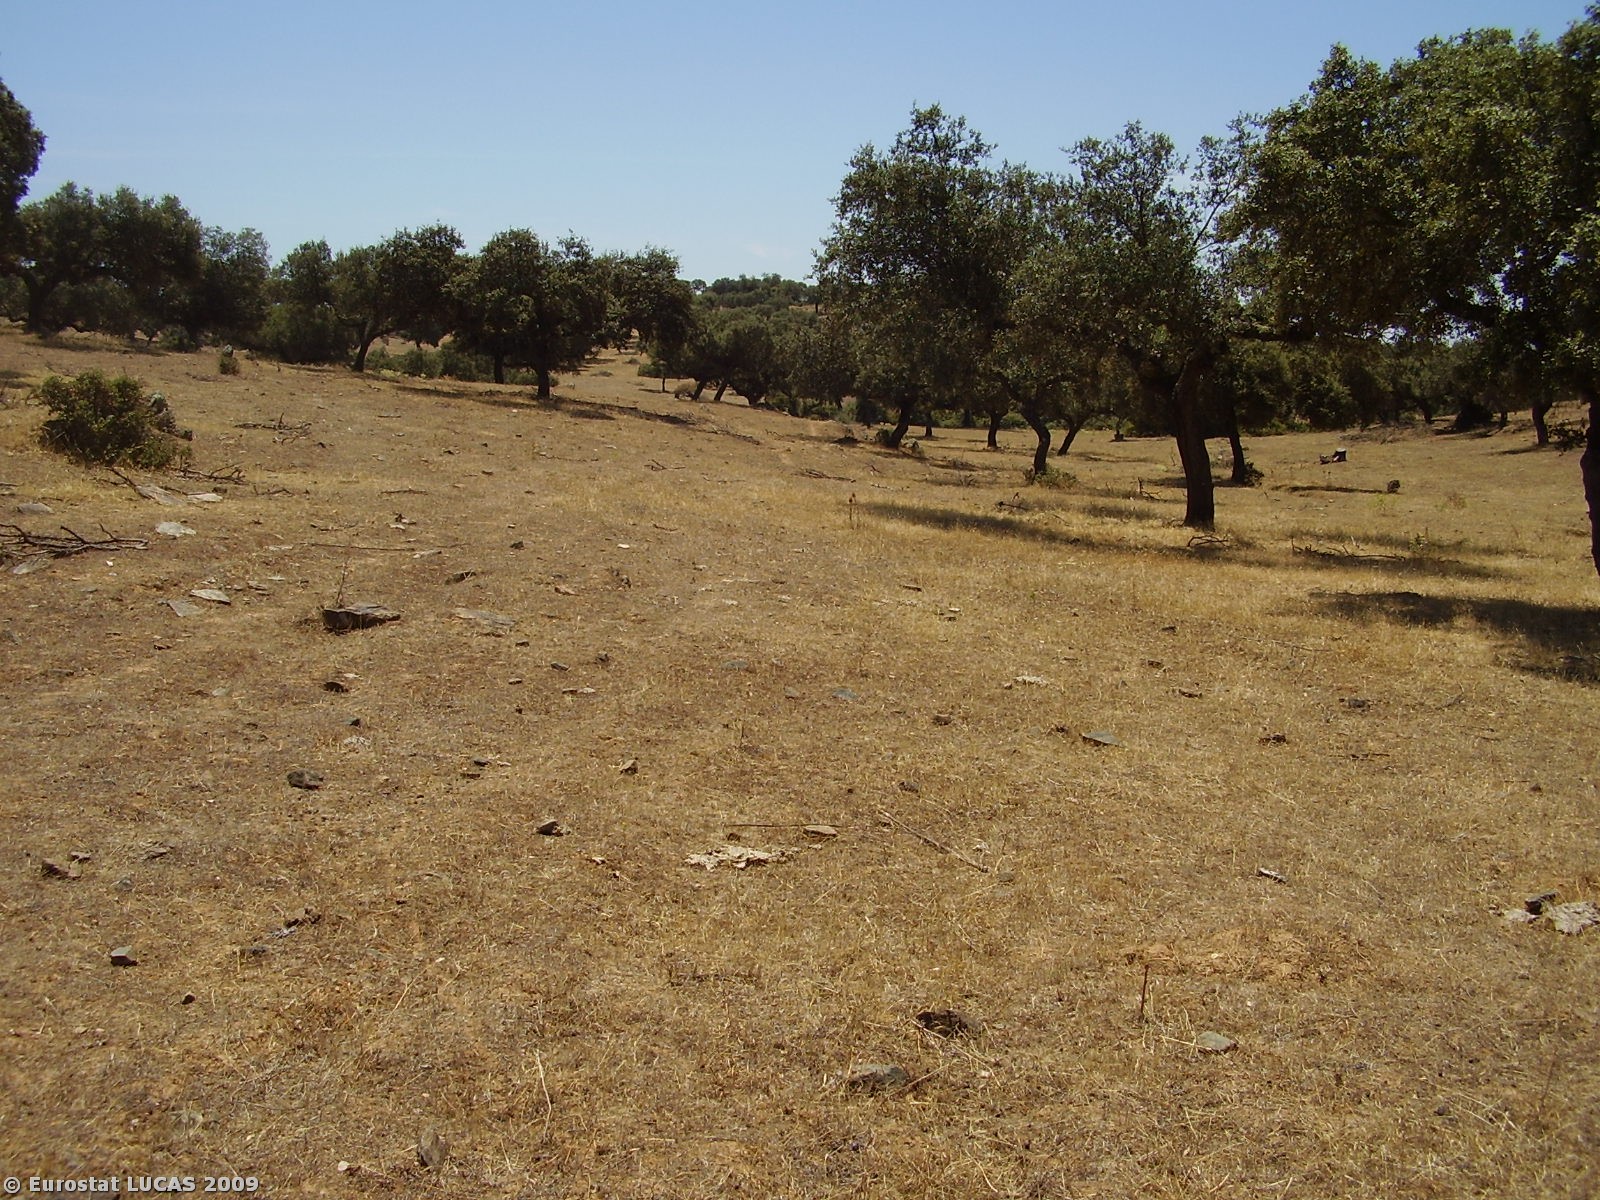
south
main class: Grassland
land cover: Grassland with sparse tree/shrub cover
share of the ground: > 75 %
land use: Fallow land
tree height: > 5 m
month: July
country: PT
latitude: 38.8285
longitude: -7.2969
